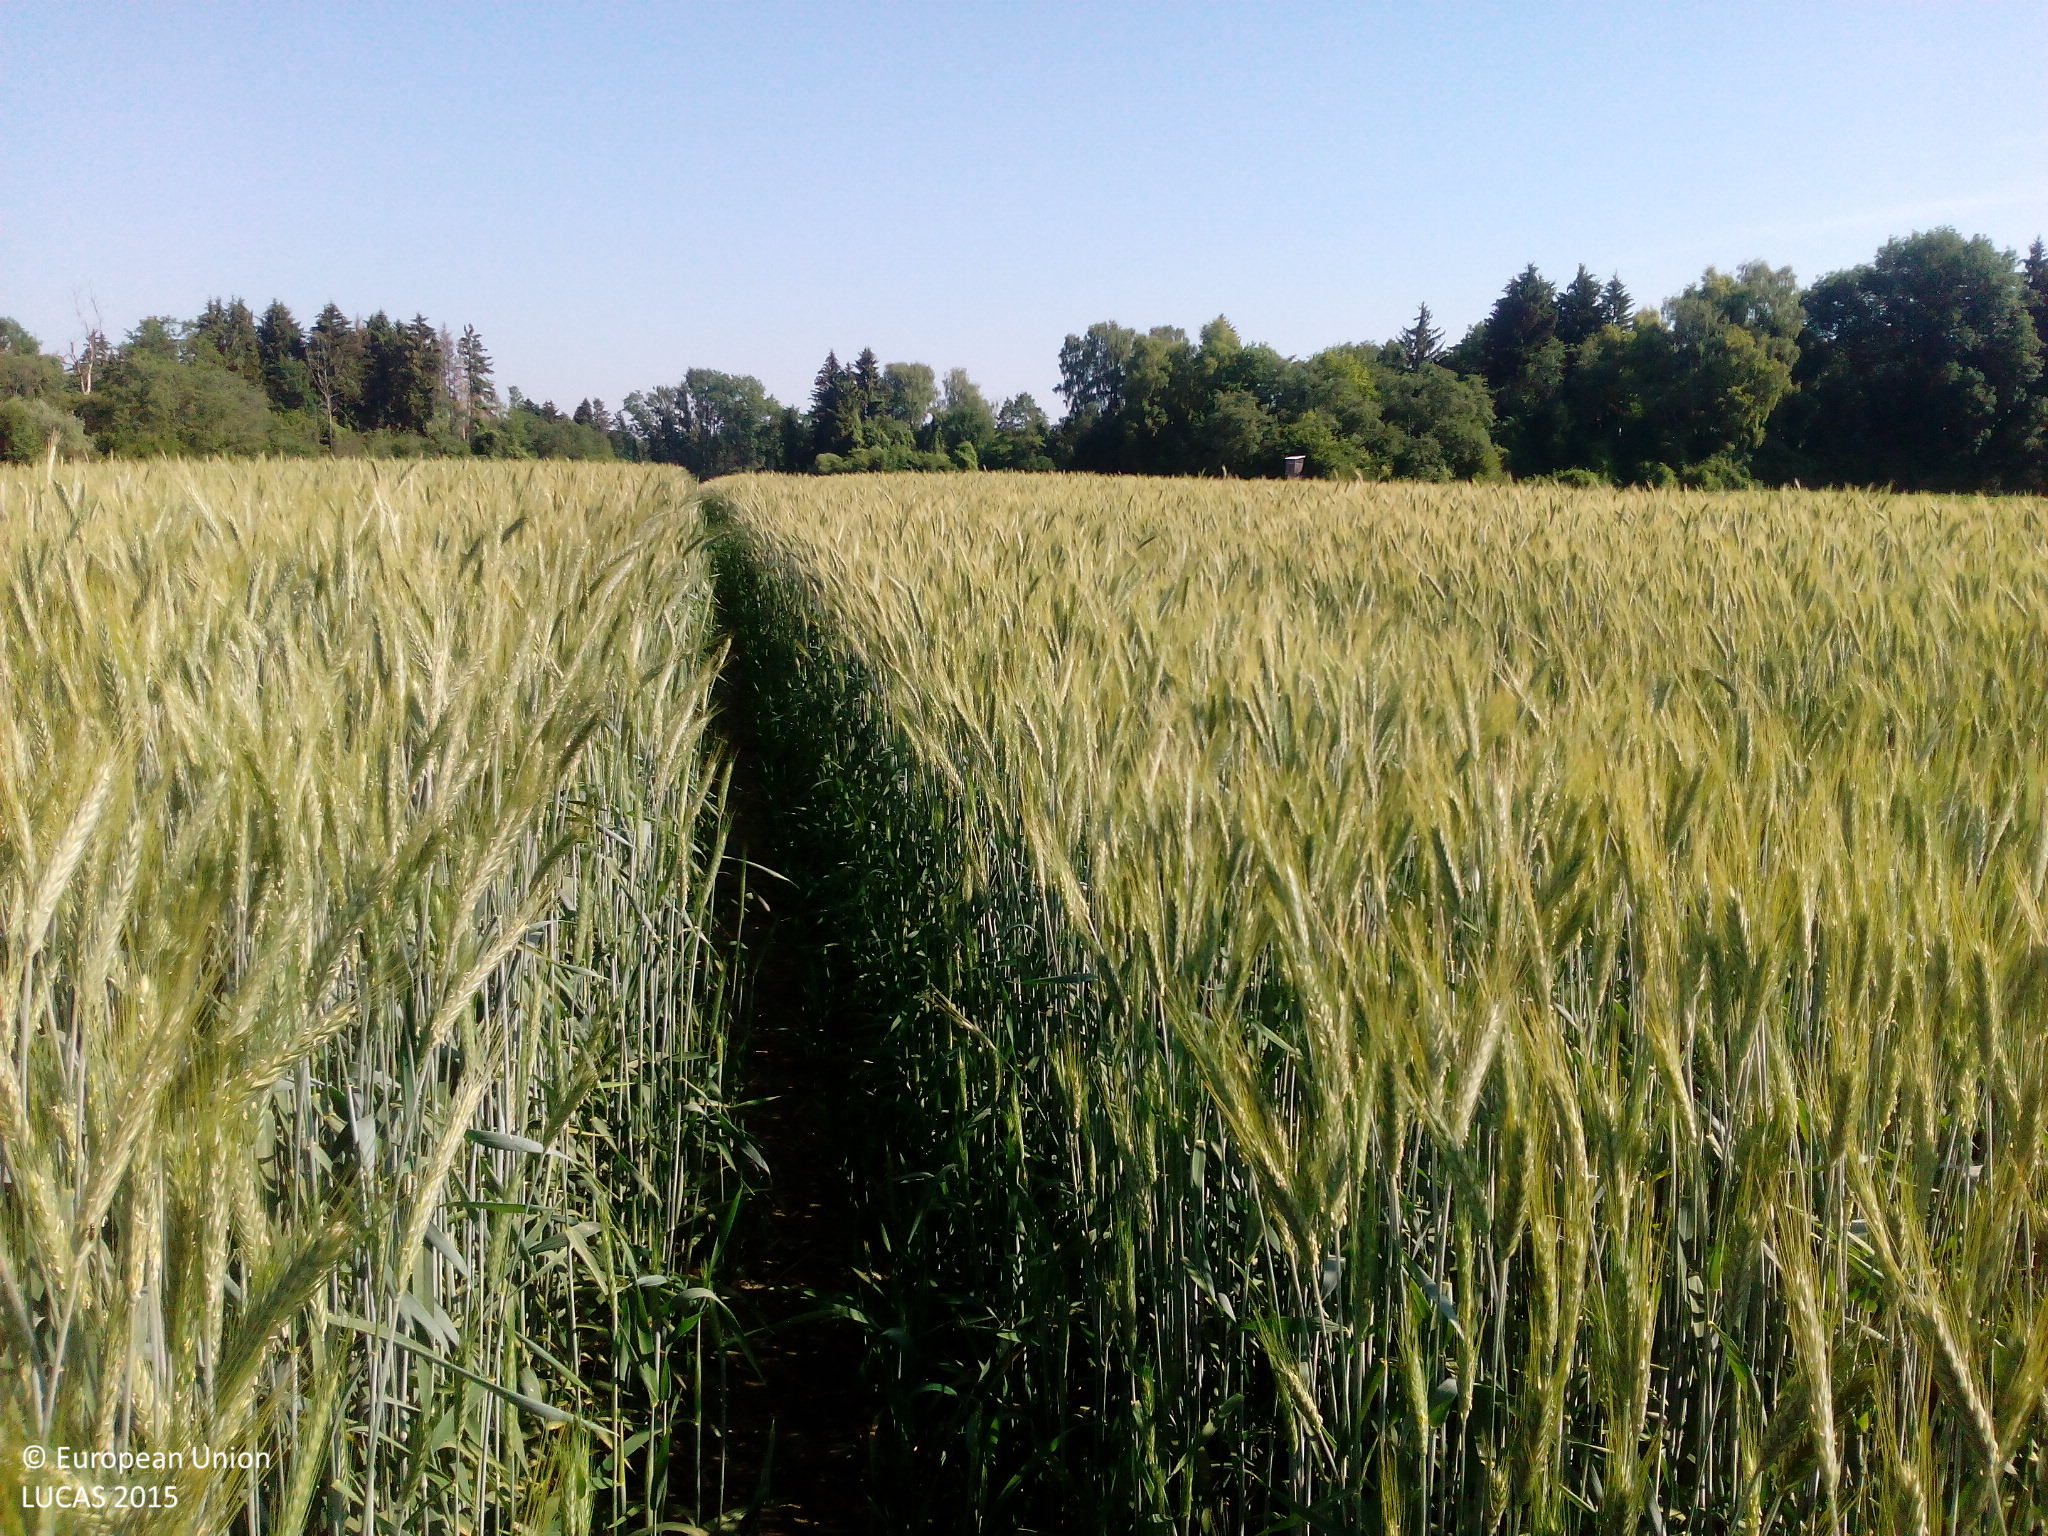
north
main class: Cropland
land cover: Rye
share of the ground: > 75 %
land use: Agriculture (excluding fallow land and kitchen gardens)
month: June
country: DE
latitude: 48.5799
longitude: 10.8806
